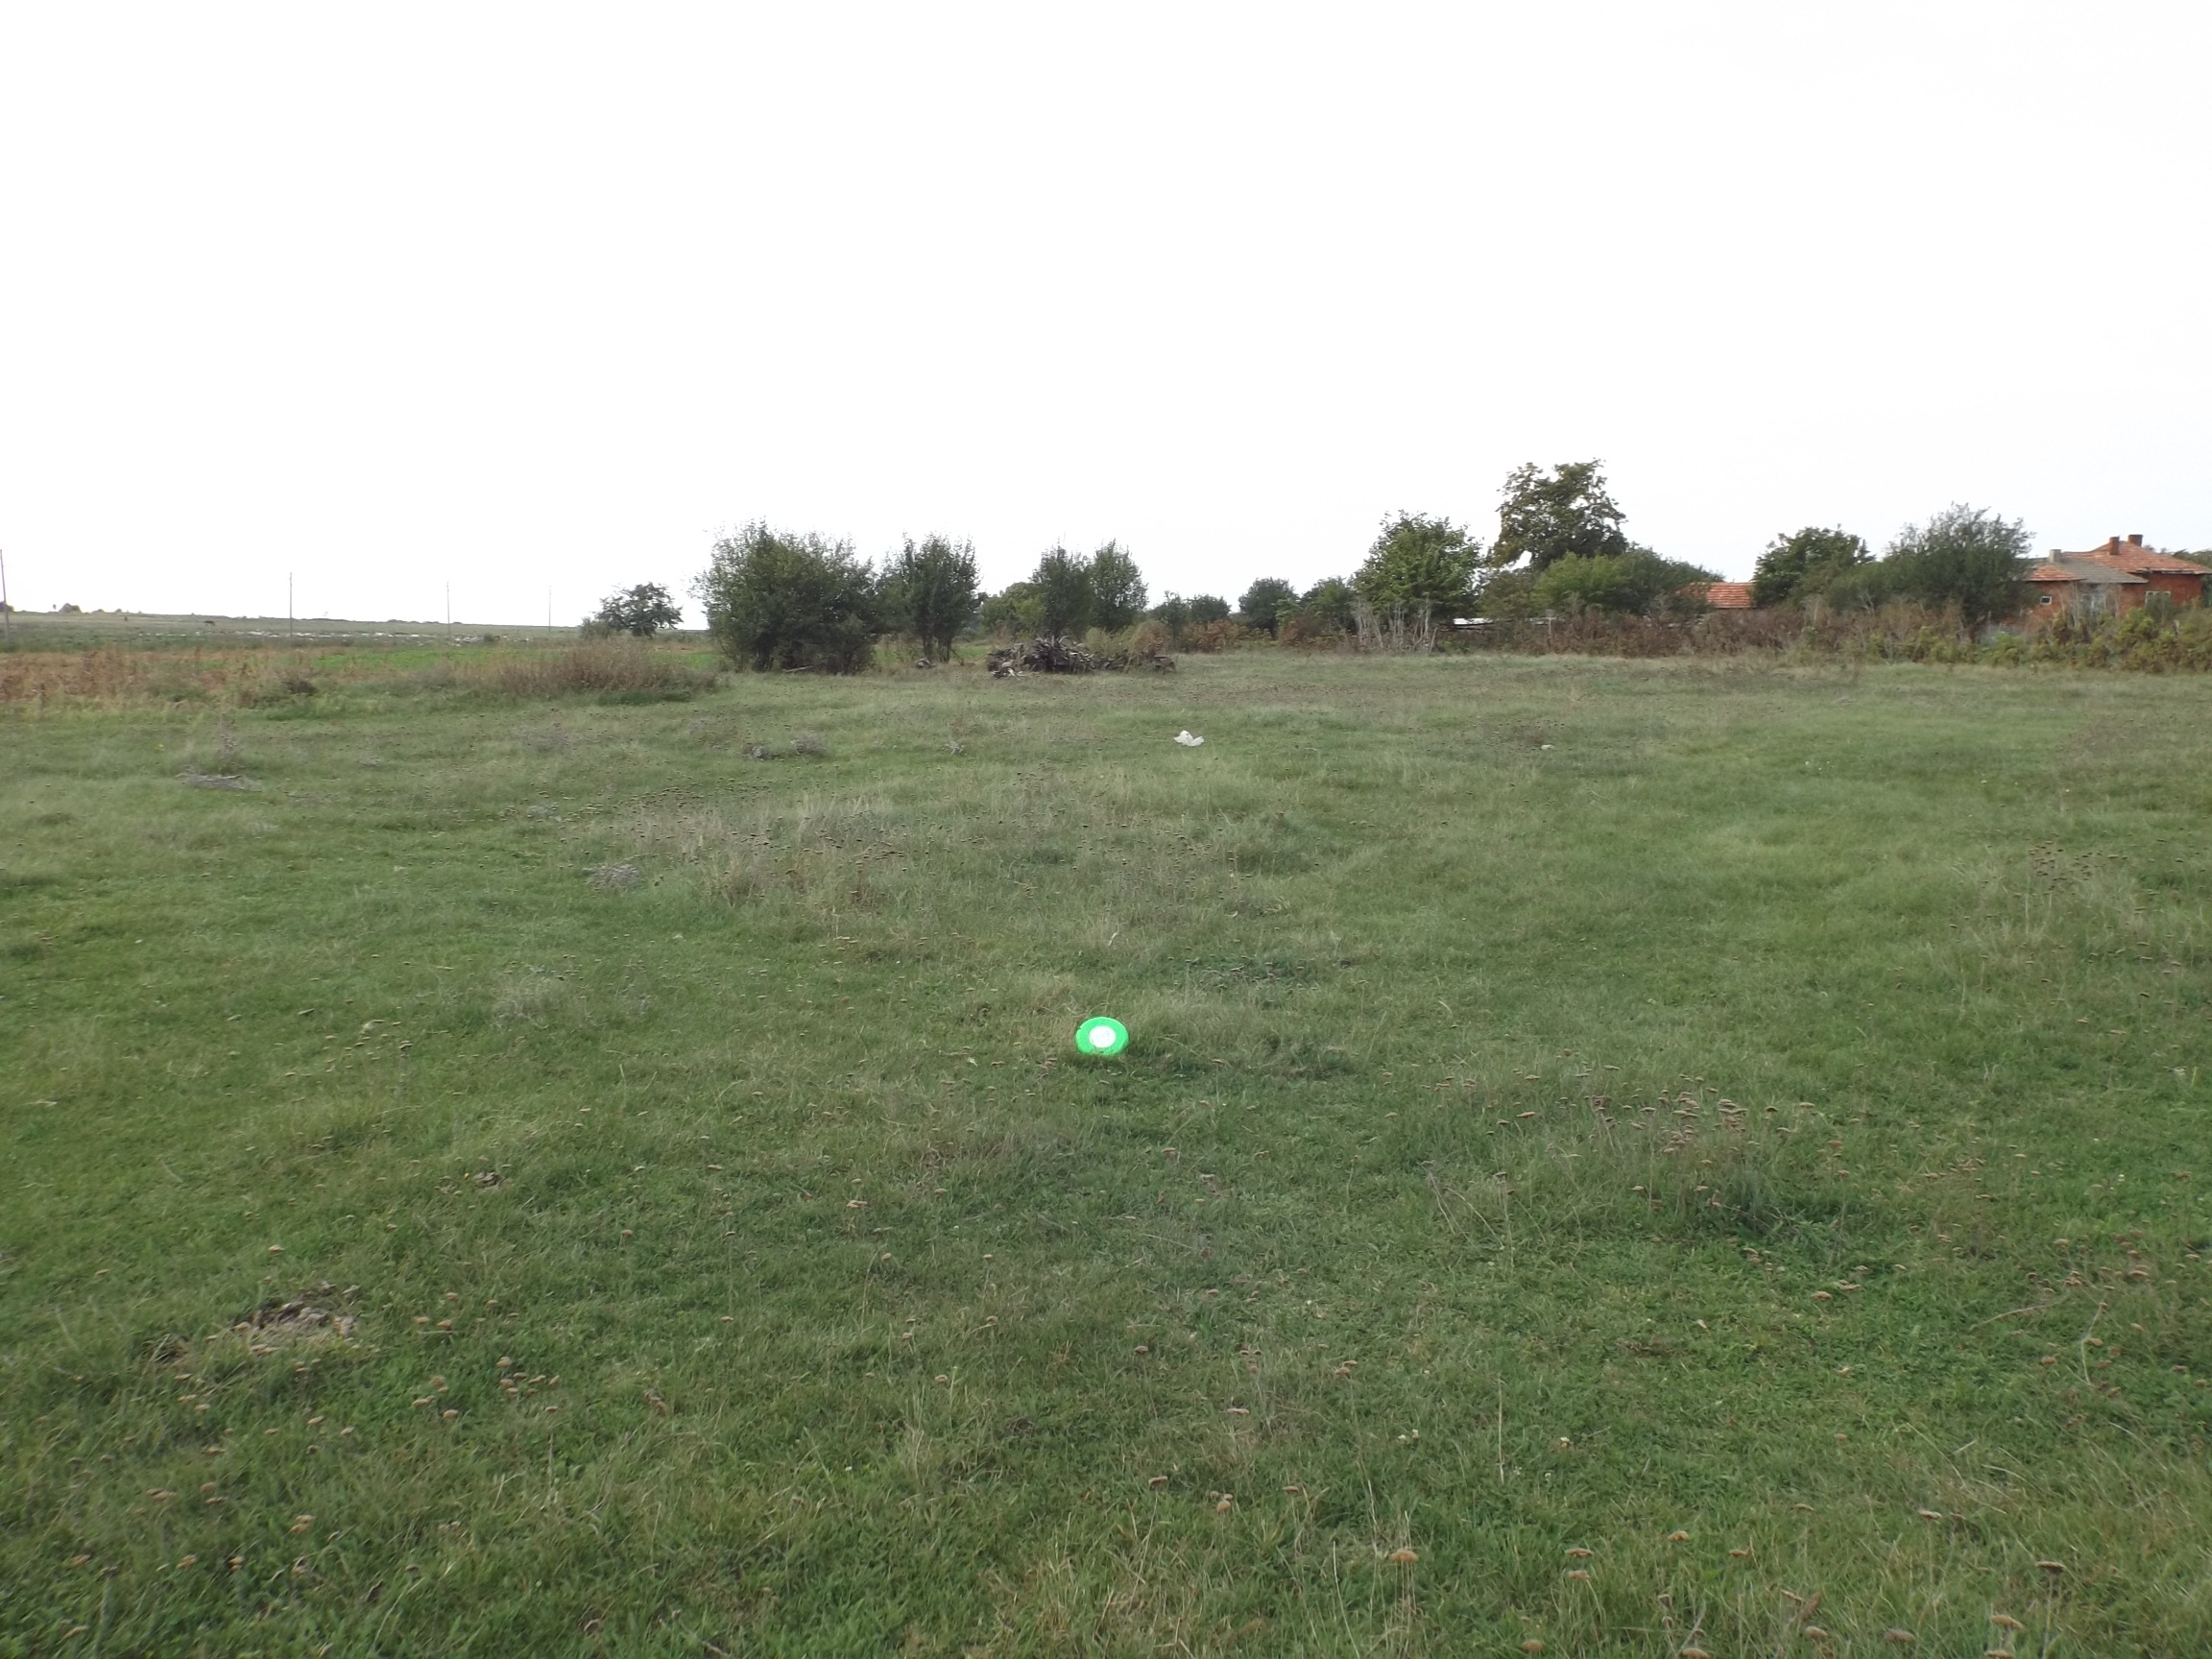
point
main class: Grassland
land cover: Grassland without tree/shrub cover
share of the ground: > 75 %
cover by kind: herbaceous plants 100 %
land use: Agriculture (excluding fallow land and kitchen gardens)
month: October
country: BG
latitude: 43.9141
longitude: 26.8680
